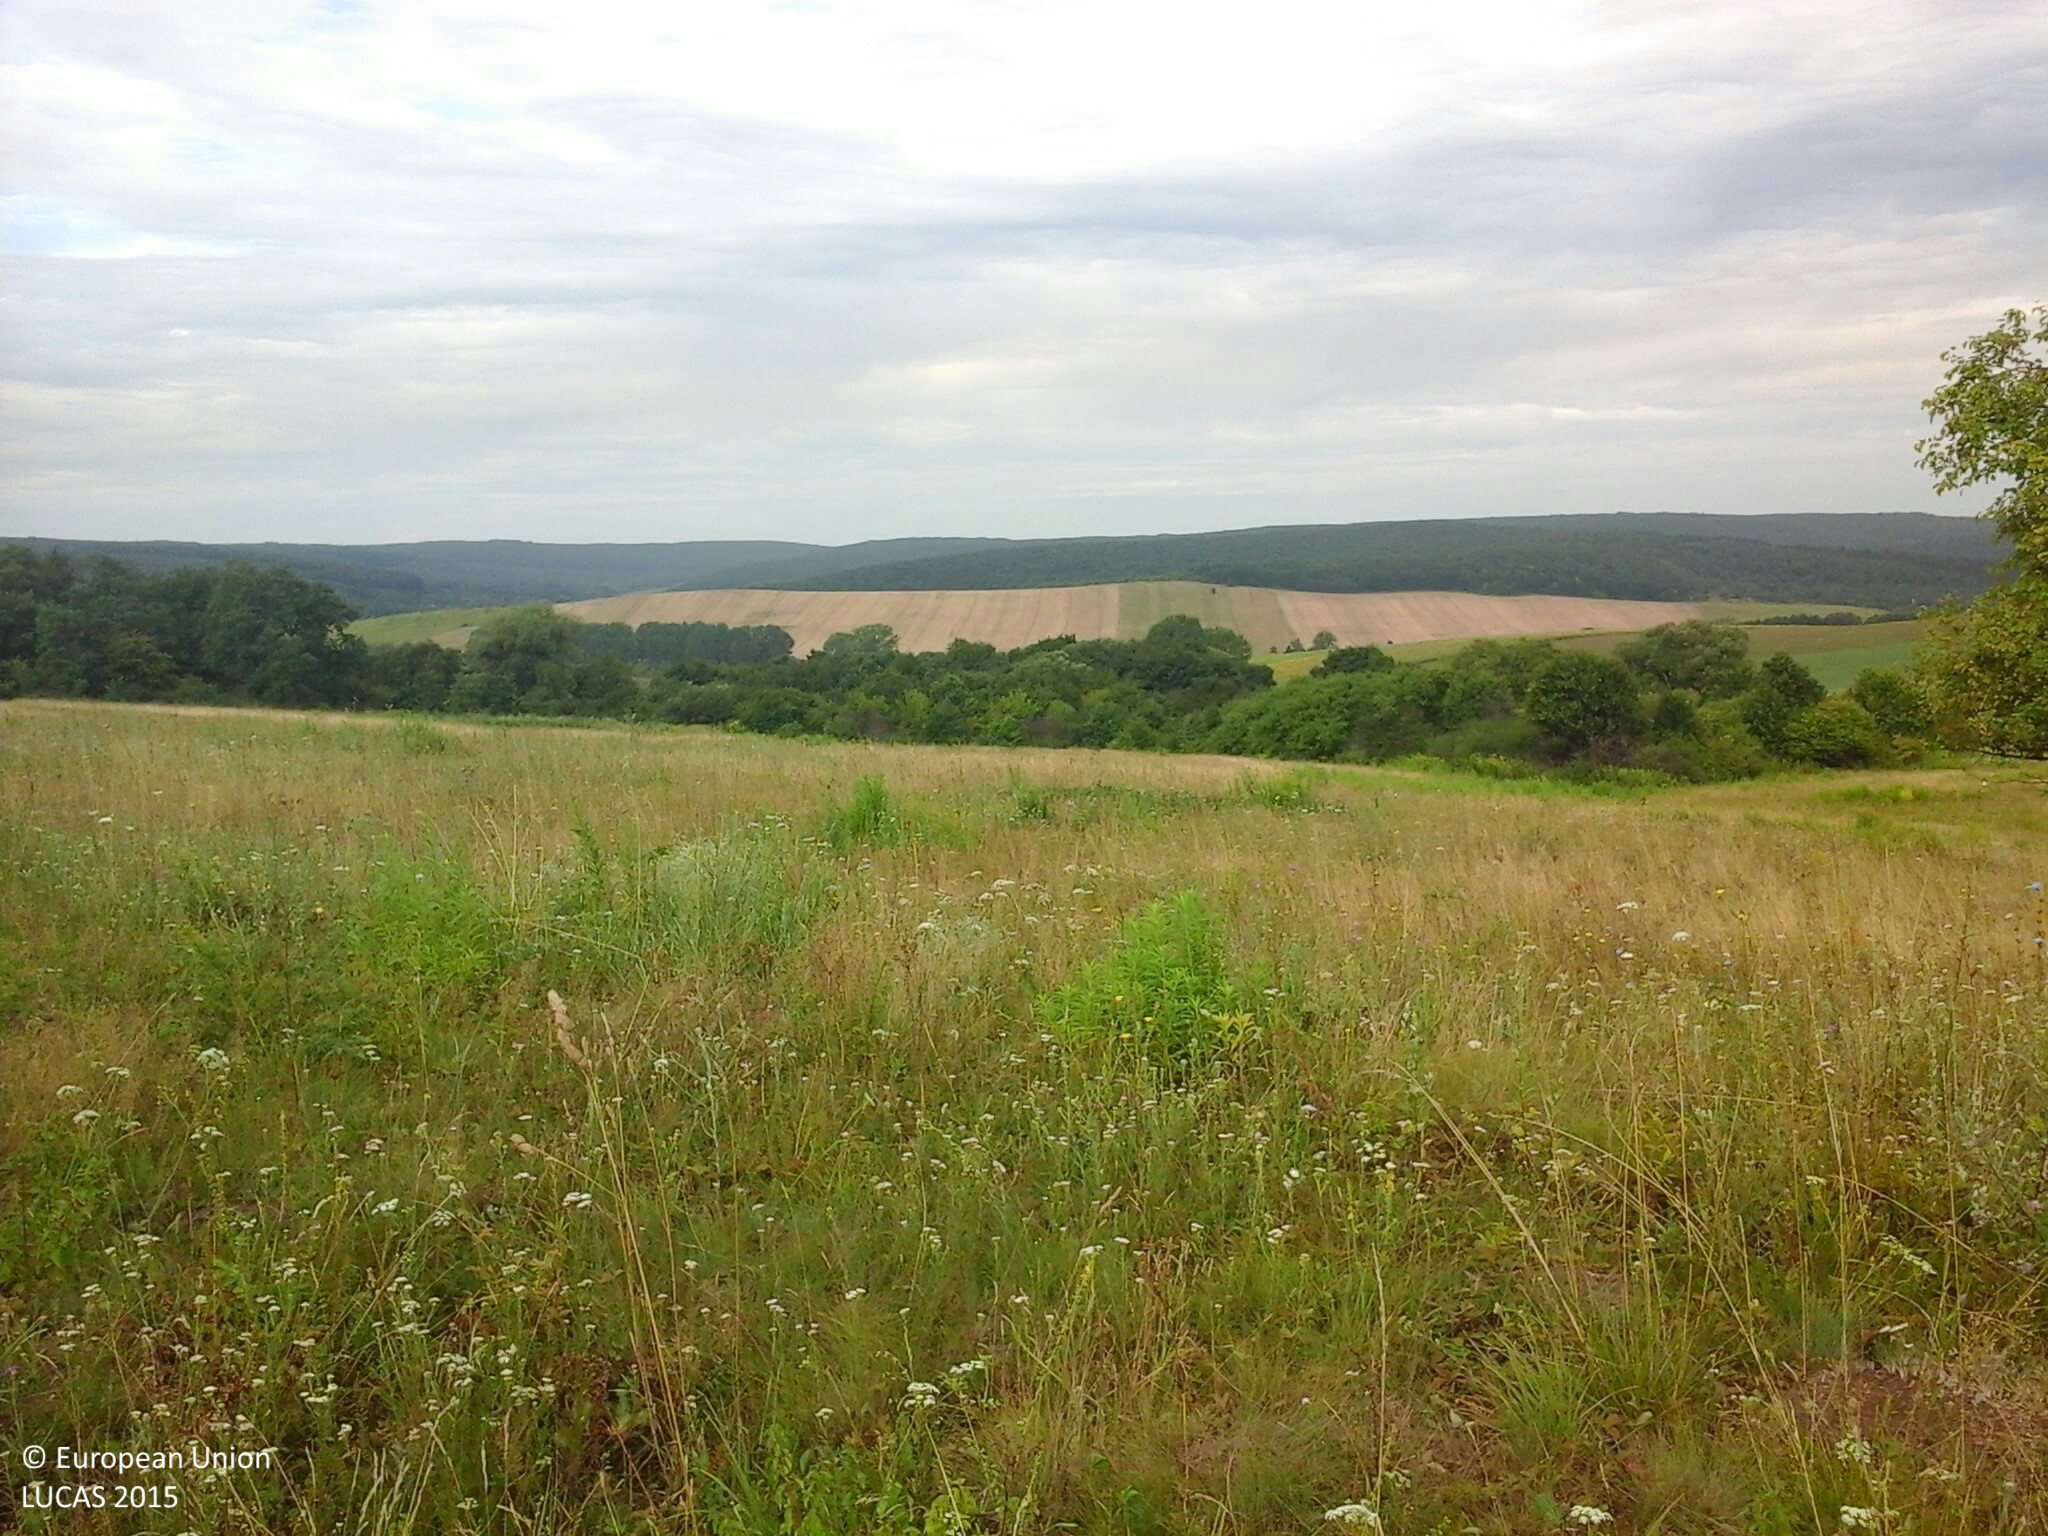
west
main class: Grassland
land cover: Grassland without tree/shrub cover
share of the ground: > 75 %
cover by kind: herbaceous plants 95 %, shrubs 5 %
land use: Agriculture (excluding fallow land and kitchen gardens)
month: July
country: HU
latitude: 48.4886
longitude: 21.1786
